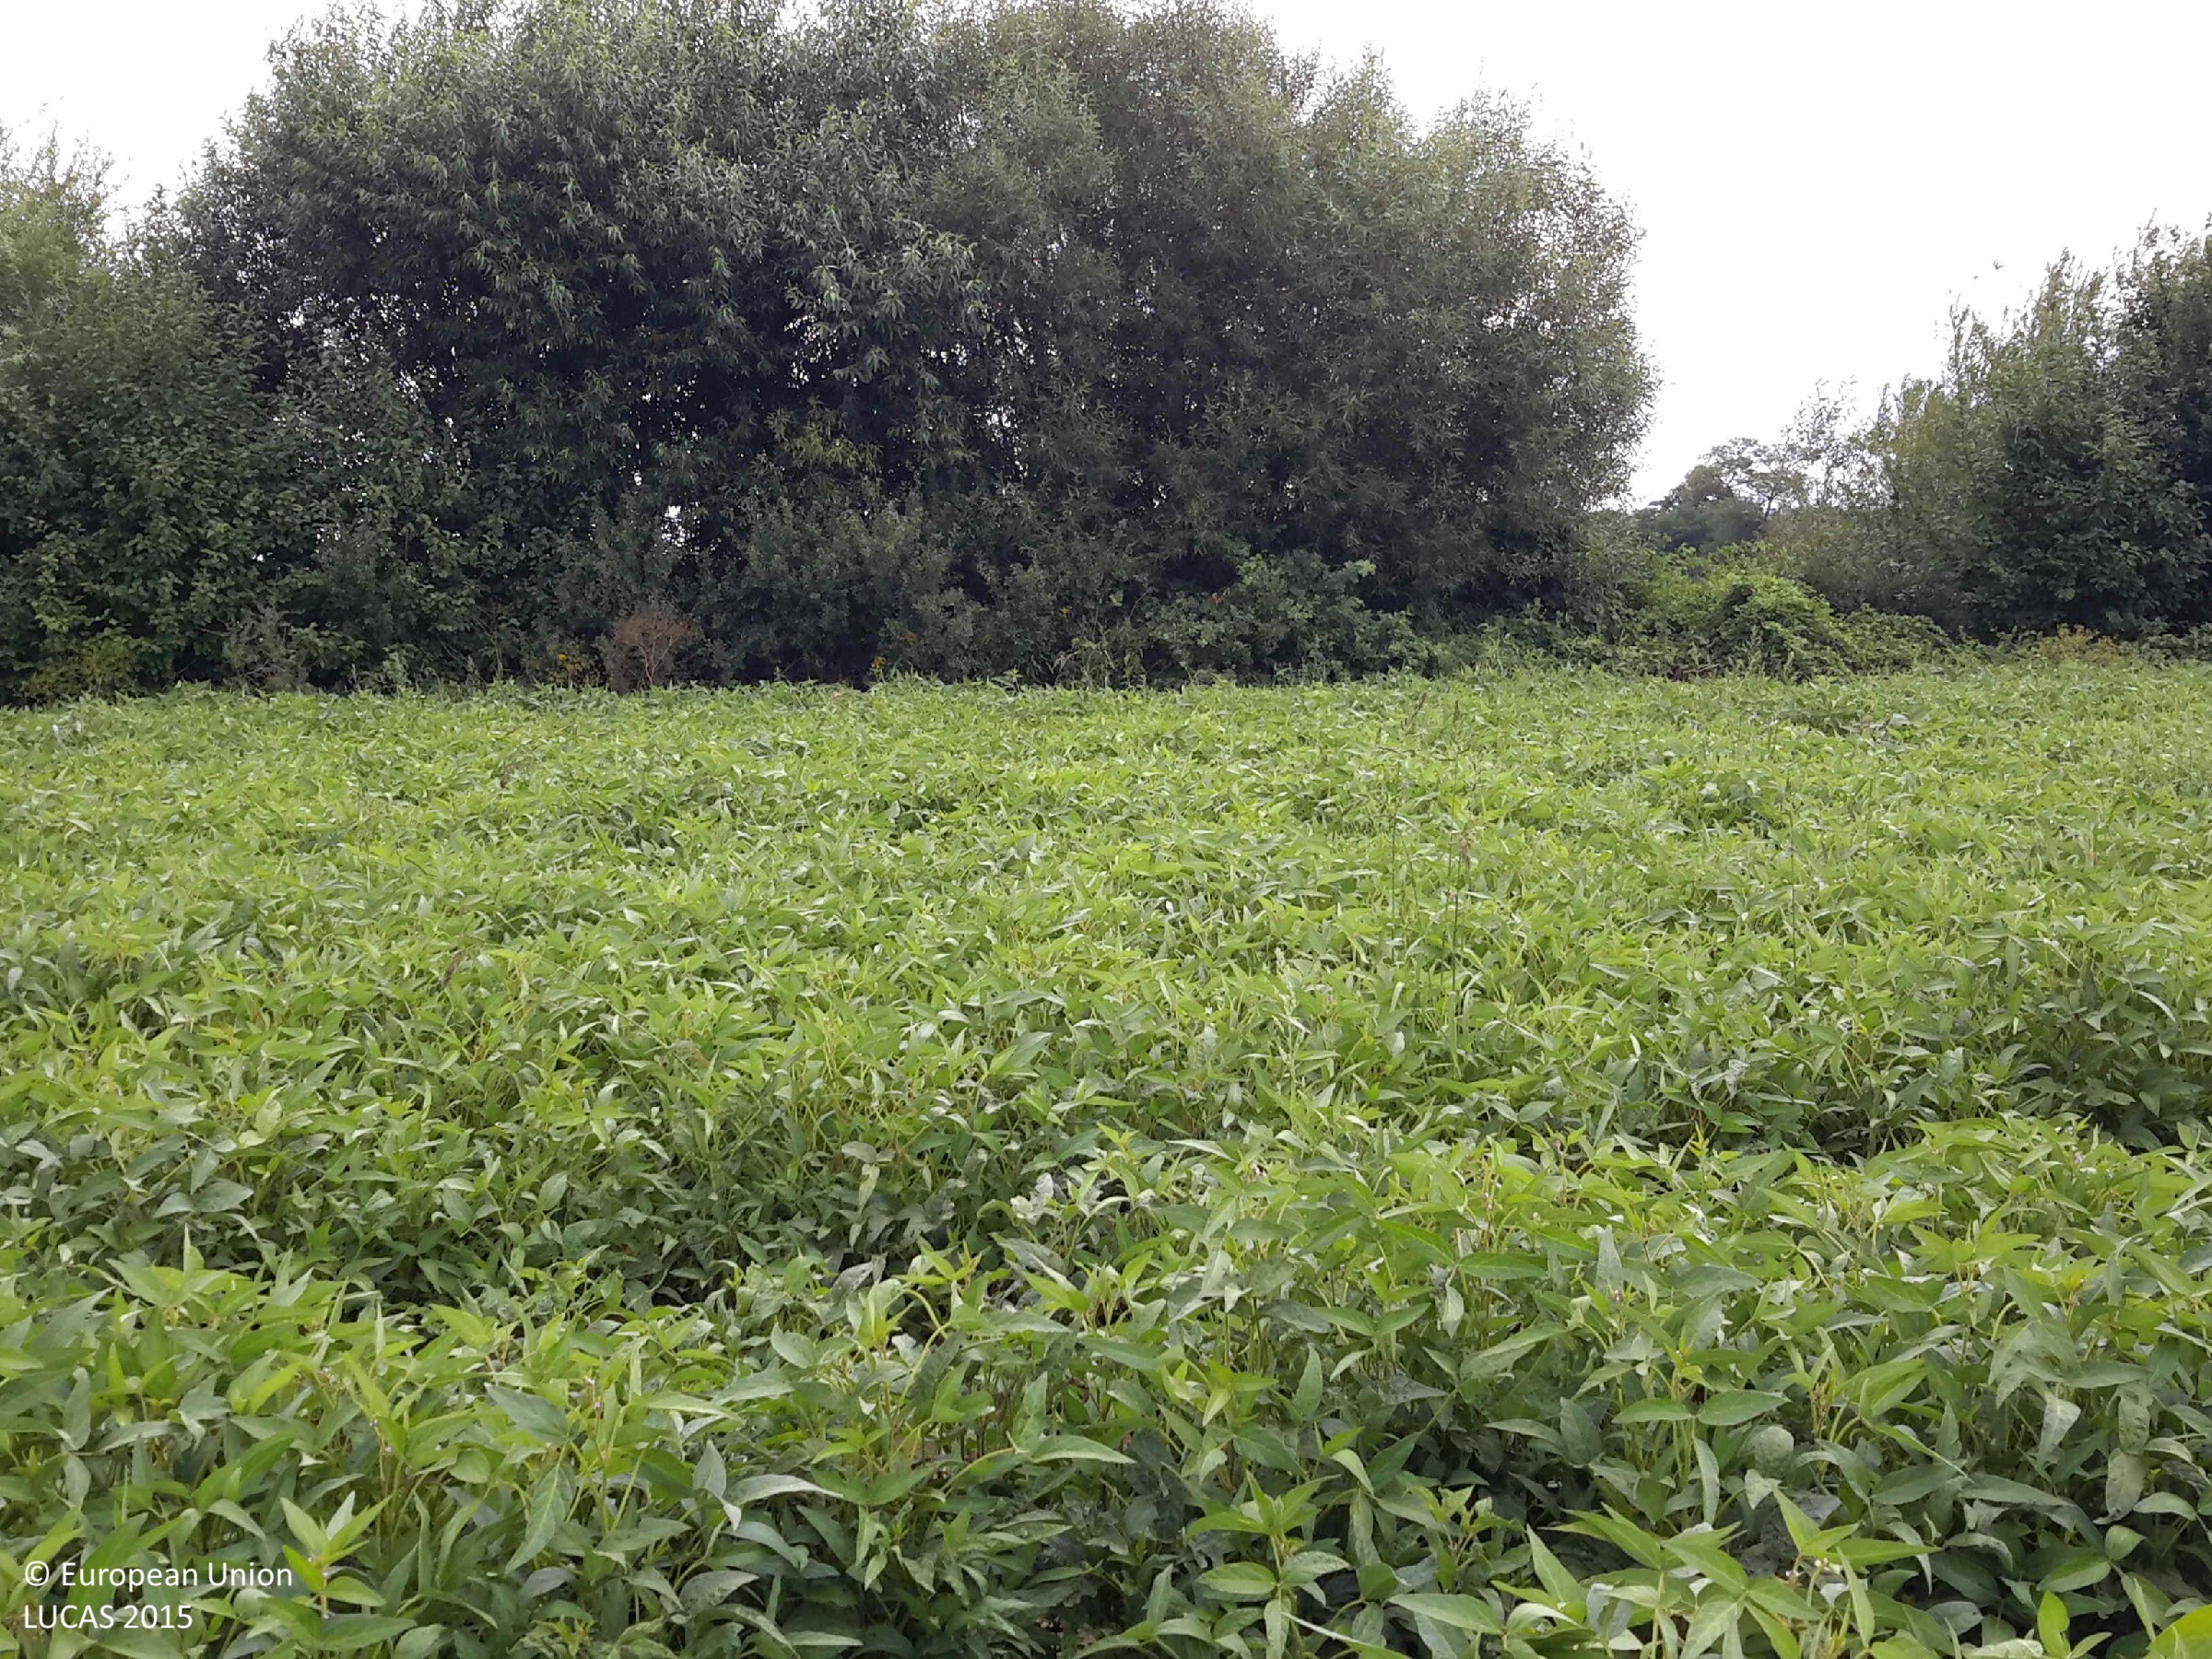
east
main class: Cropland
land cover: Soya
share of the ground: > 75 %
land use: Agriculture (excluding fallow land and kitchen gardens)
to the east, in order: Soya; Shrubland with sparse tree cover; Ditches and canals; Grass margins; Barley; Shrubland with sparse tree cover
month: July
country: HU
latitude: 47.3195
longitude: 16.6321
